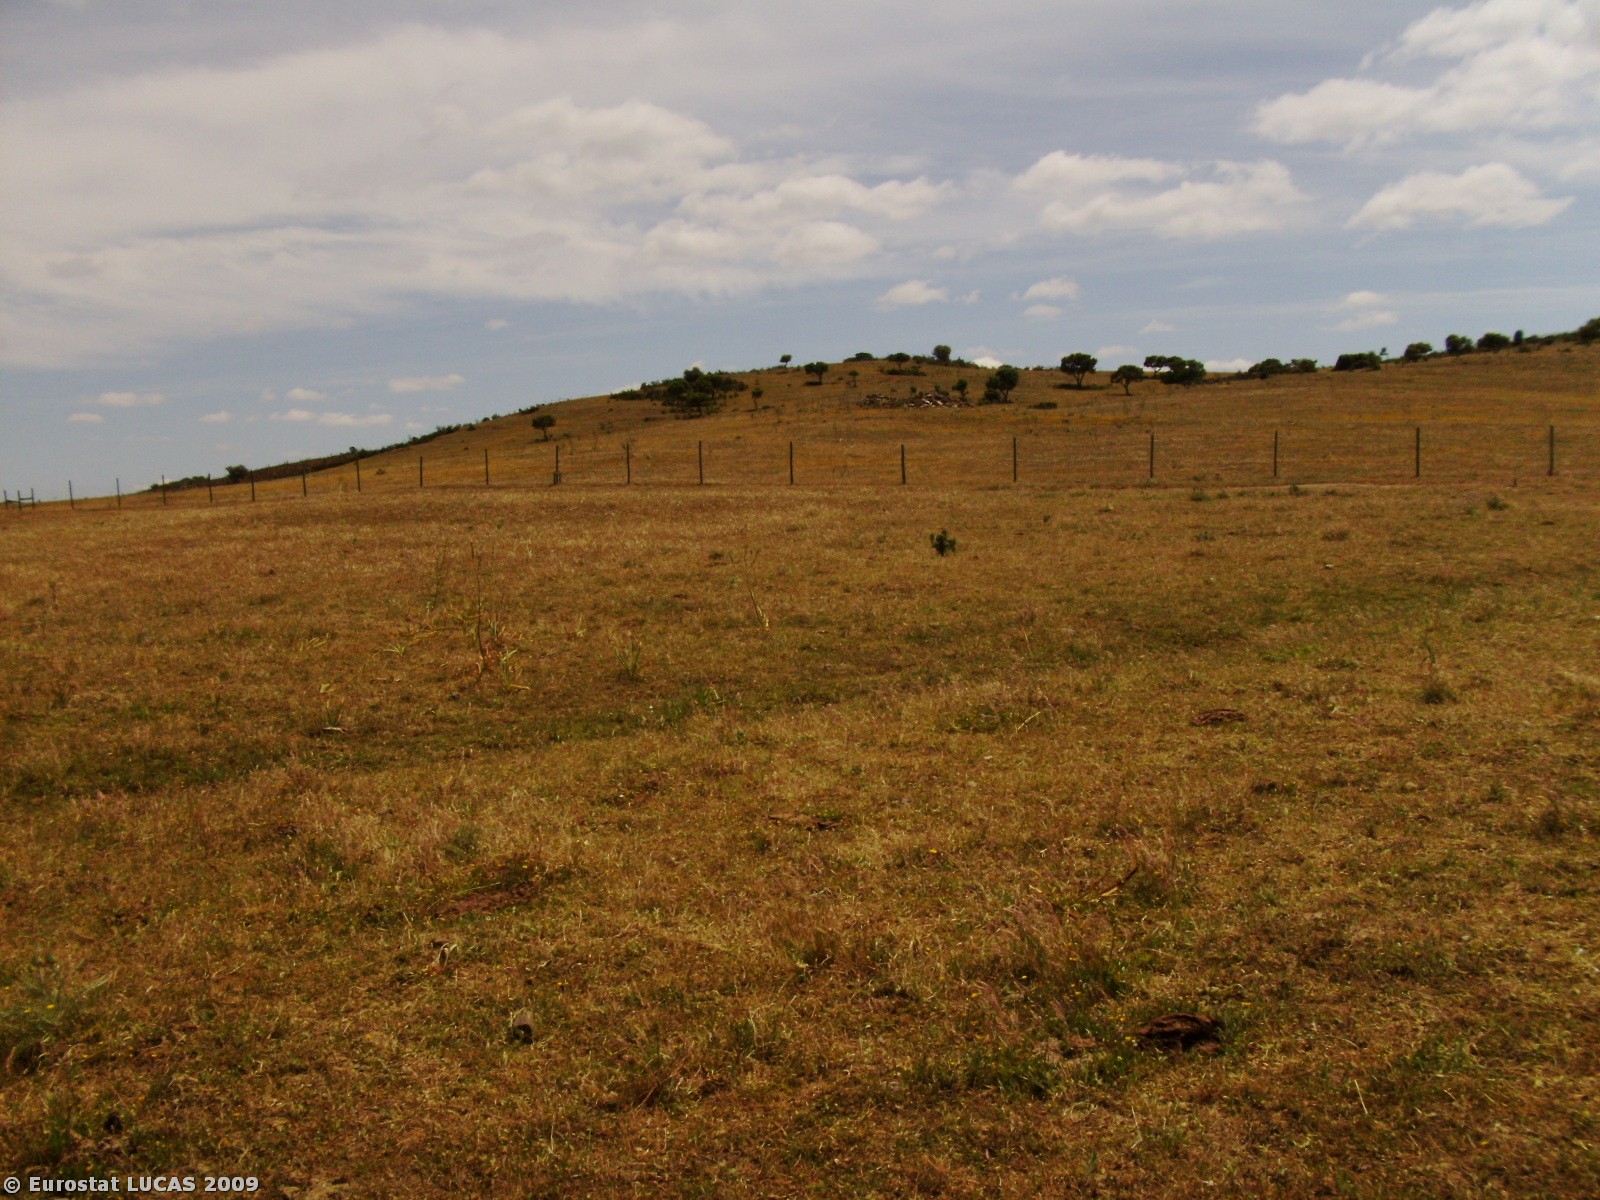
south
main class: Grassland
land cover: Grassland without tree/shrub cover
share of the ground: 50 - 75 %
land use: Agriculture (excluding fallow land and kitchen gardens)
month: April
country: PT
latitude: 37.5433
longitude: -7.7510
